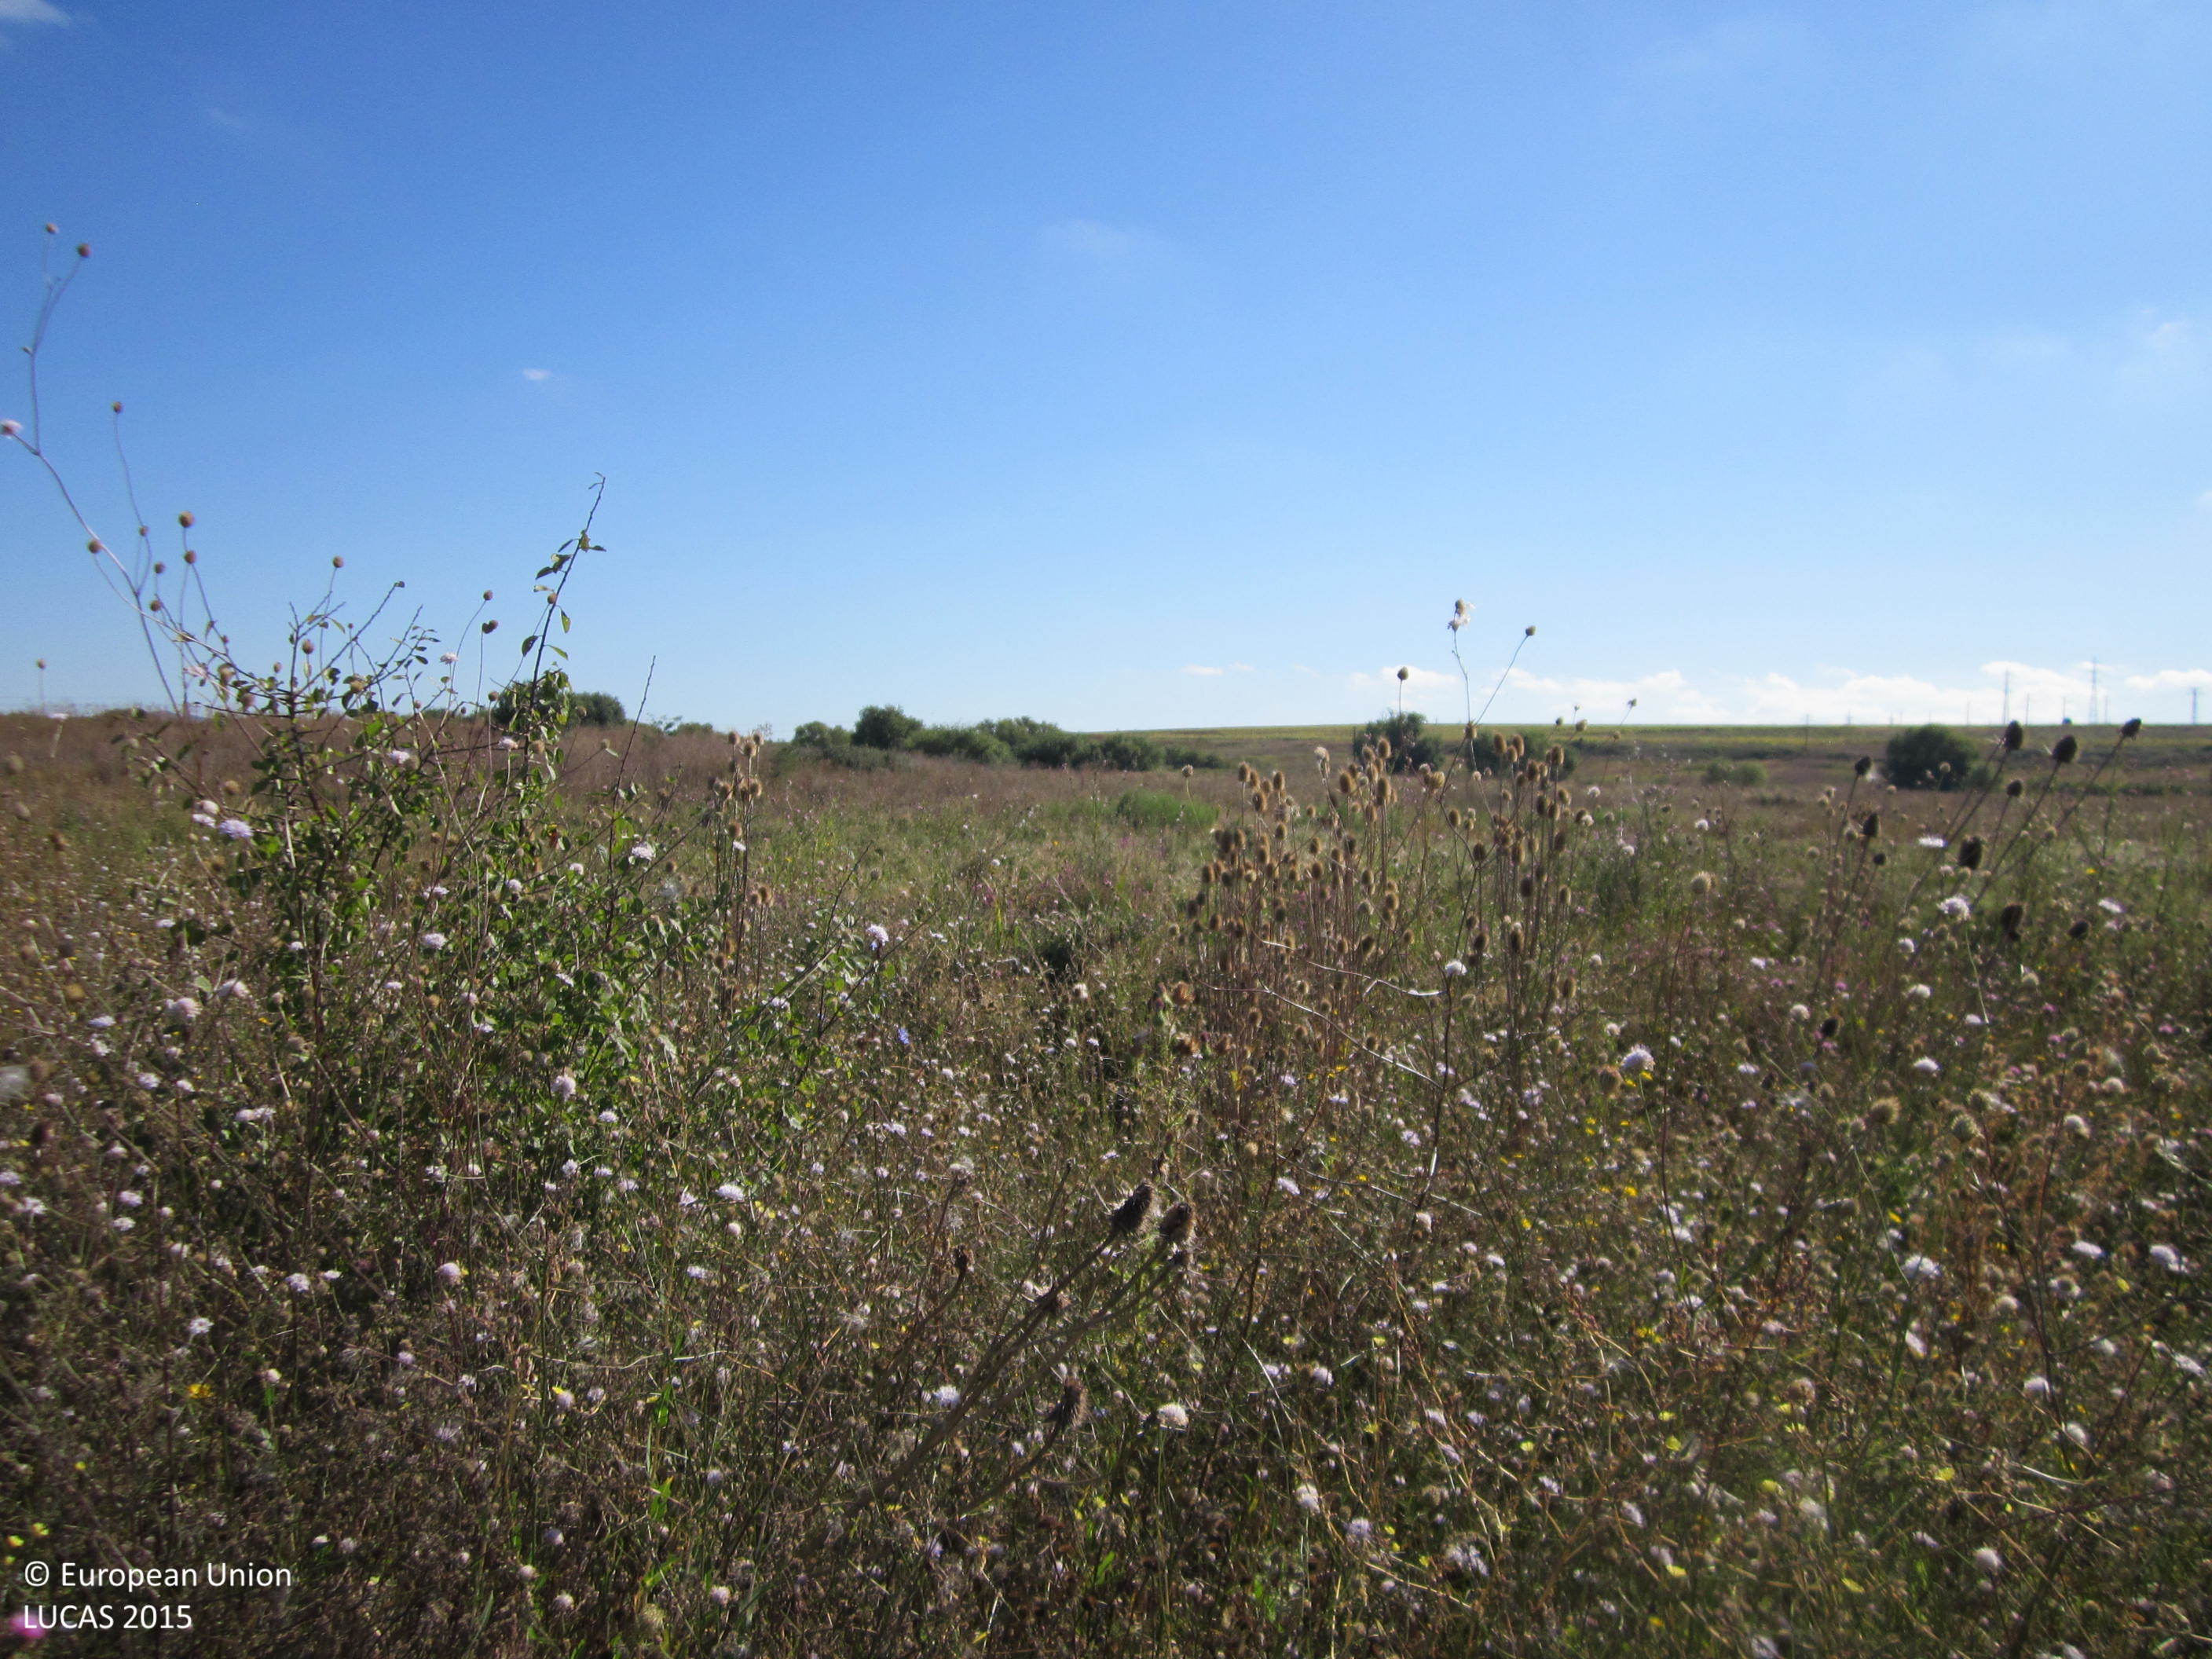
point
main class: Grassland
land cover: Grassland without tree/shrub cover
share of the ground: > 75 %
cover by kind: herbaceous plants 100 %
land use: Semi-natural and natural areas not in use
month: September
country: BG
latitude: 42.5837
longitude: 27.3315
